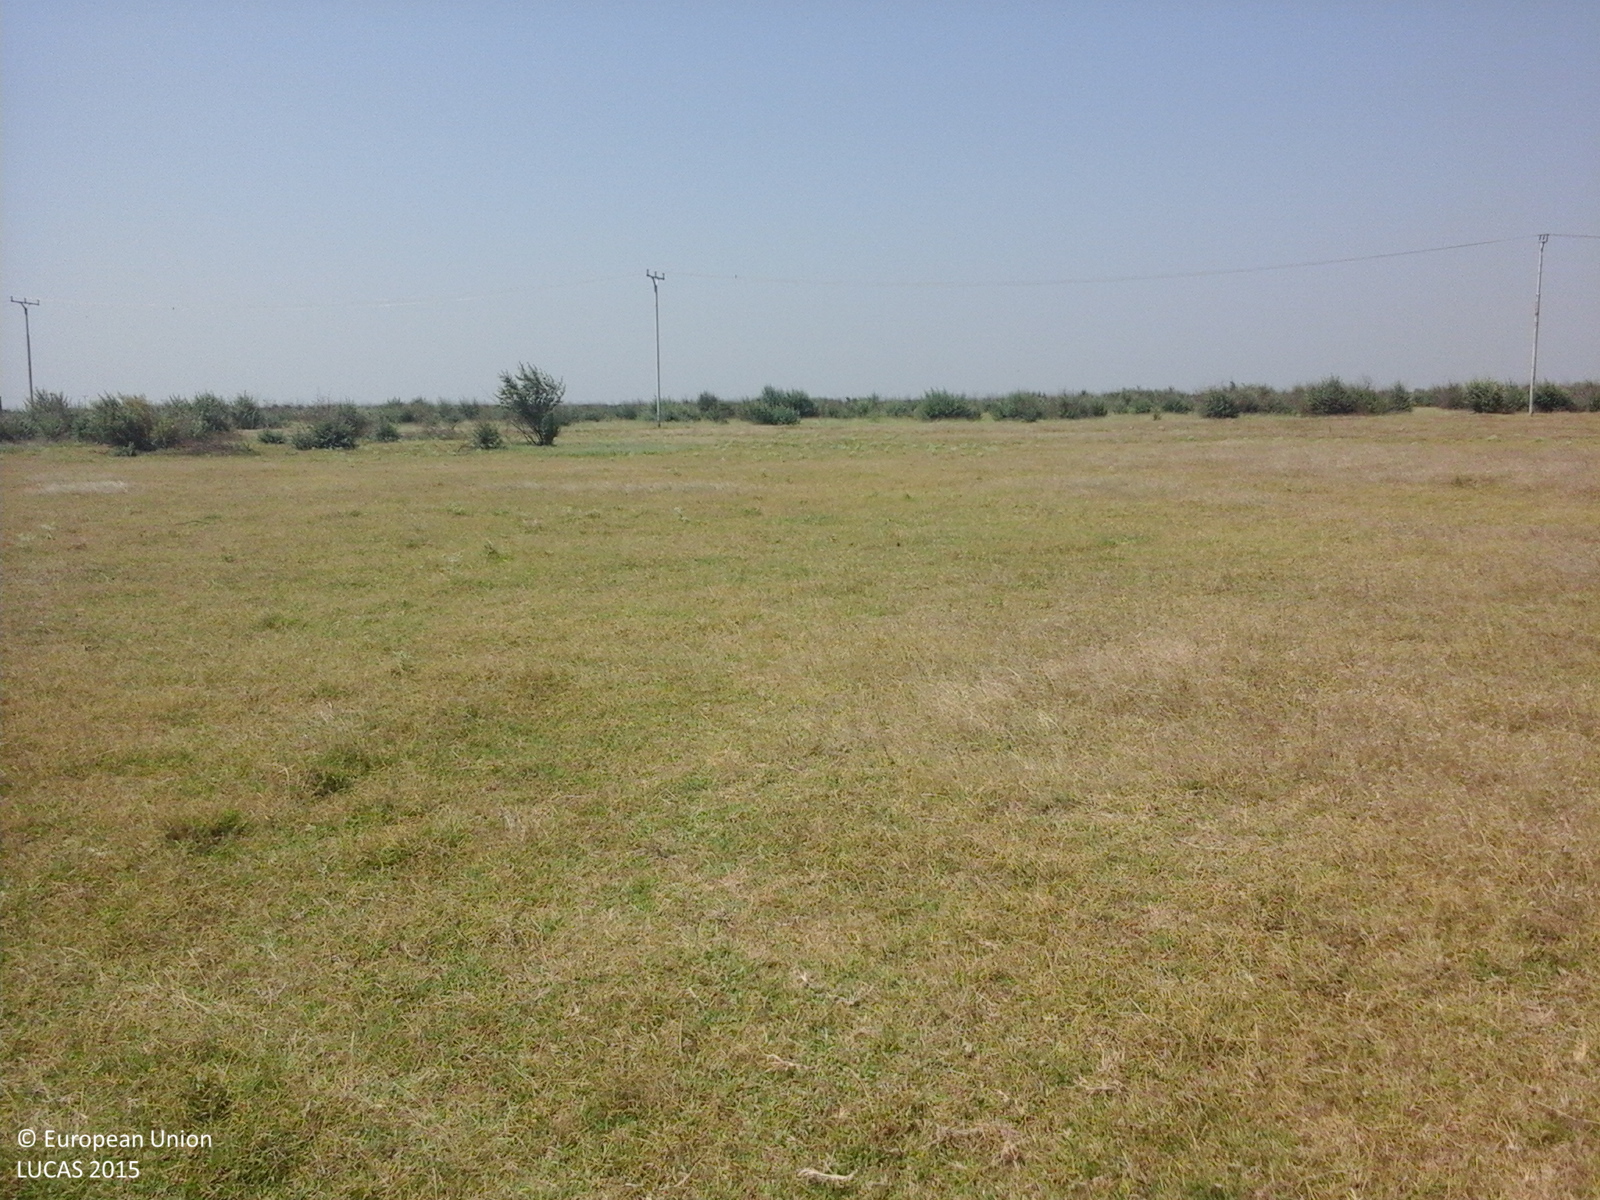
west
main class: Grassland
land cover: Grassland without tree/shrub cover
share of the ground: > 75 %
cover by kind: herbaceous plants 100 %
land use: Agriculture (excluding fallow land and kitchen gardens)
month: August
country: RO
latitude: 45.1266
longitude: 27.3210
